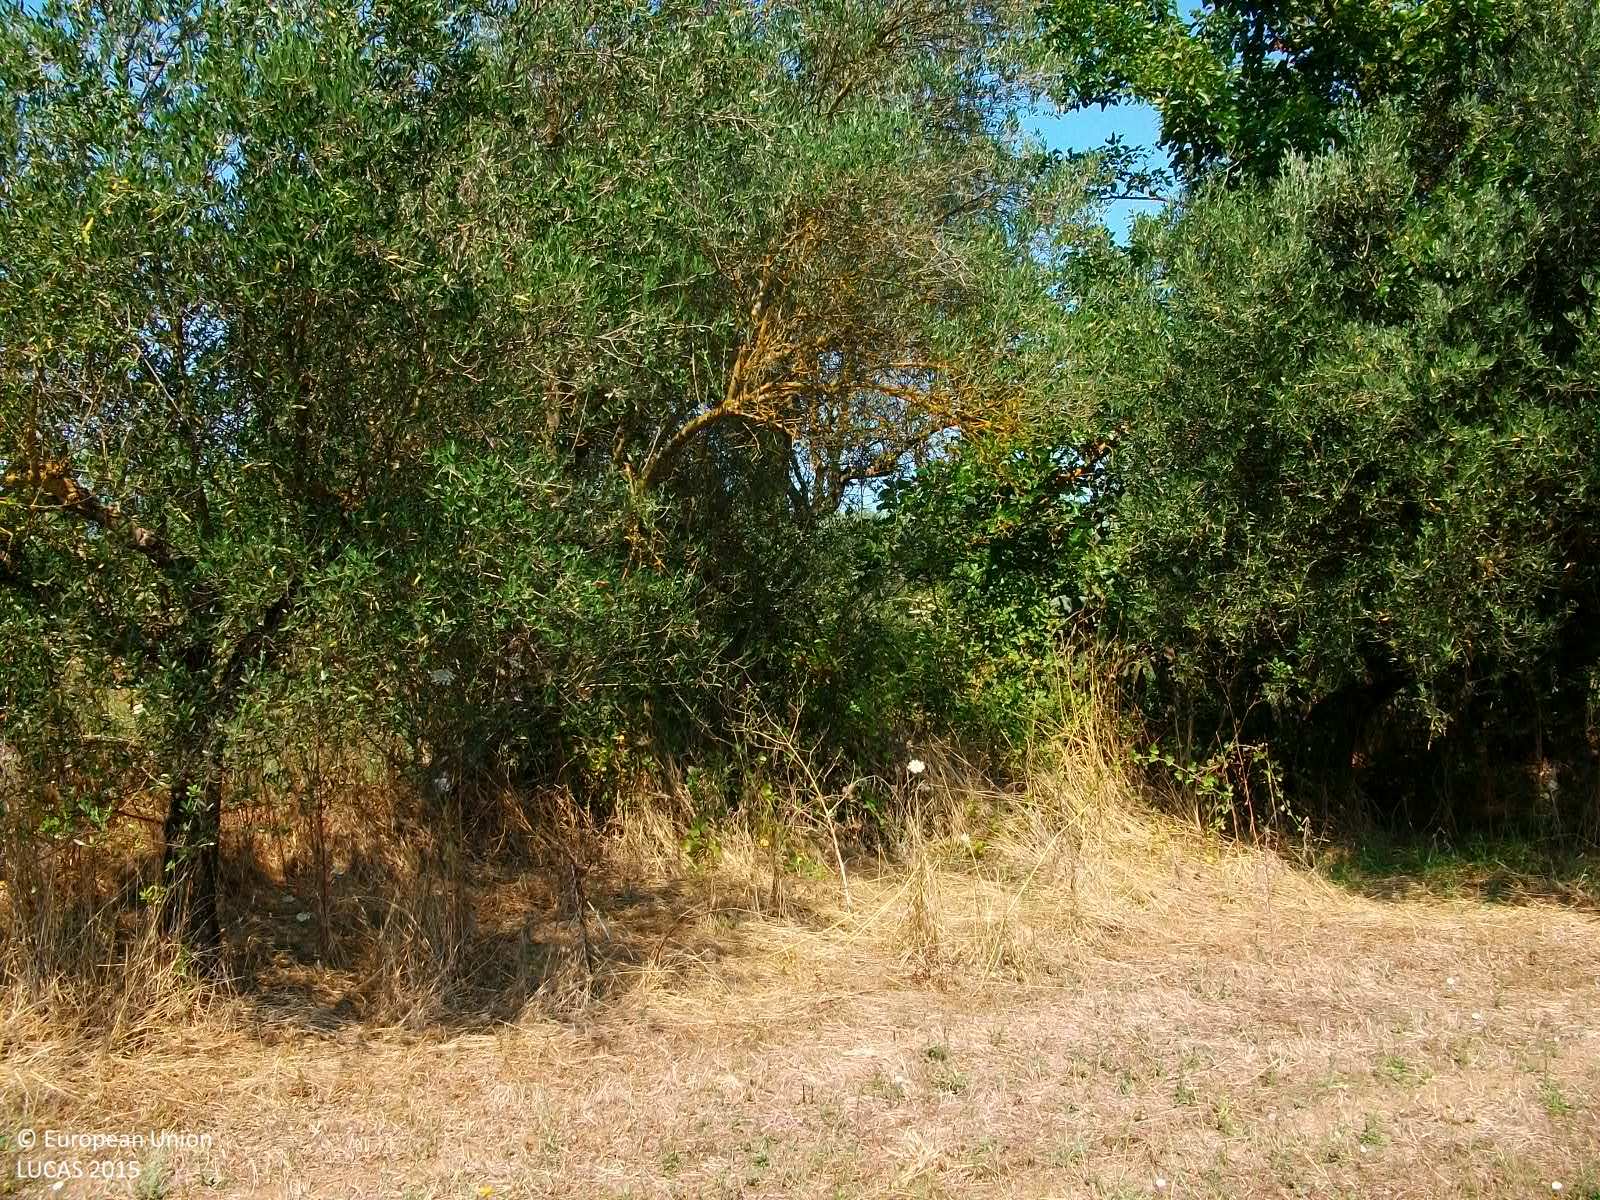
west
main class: Grassland
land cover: Spontaneously vegetated surfaces
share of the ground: > 75 %
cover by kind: herbaceous plants 100 %
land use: Fallow land
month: July
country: GR
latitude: 37.2432
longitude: 21.9840
